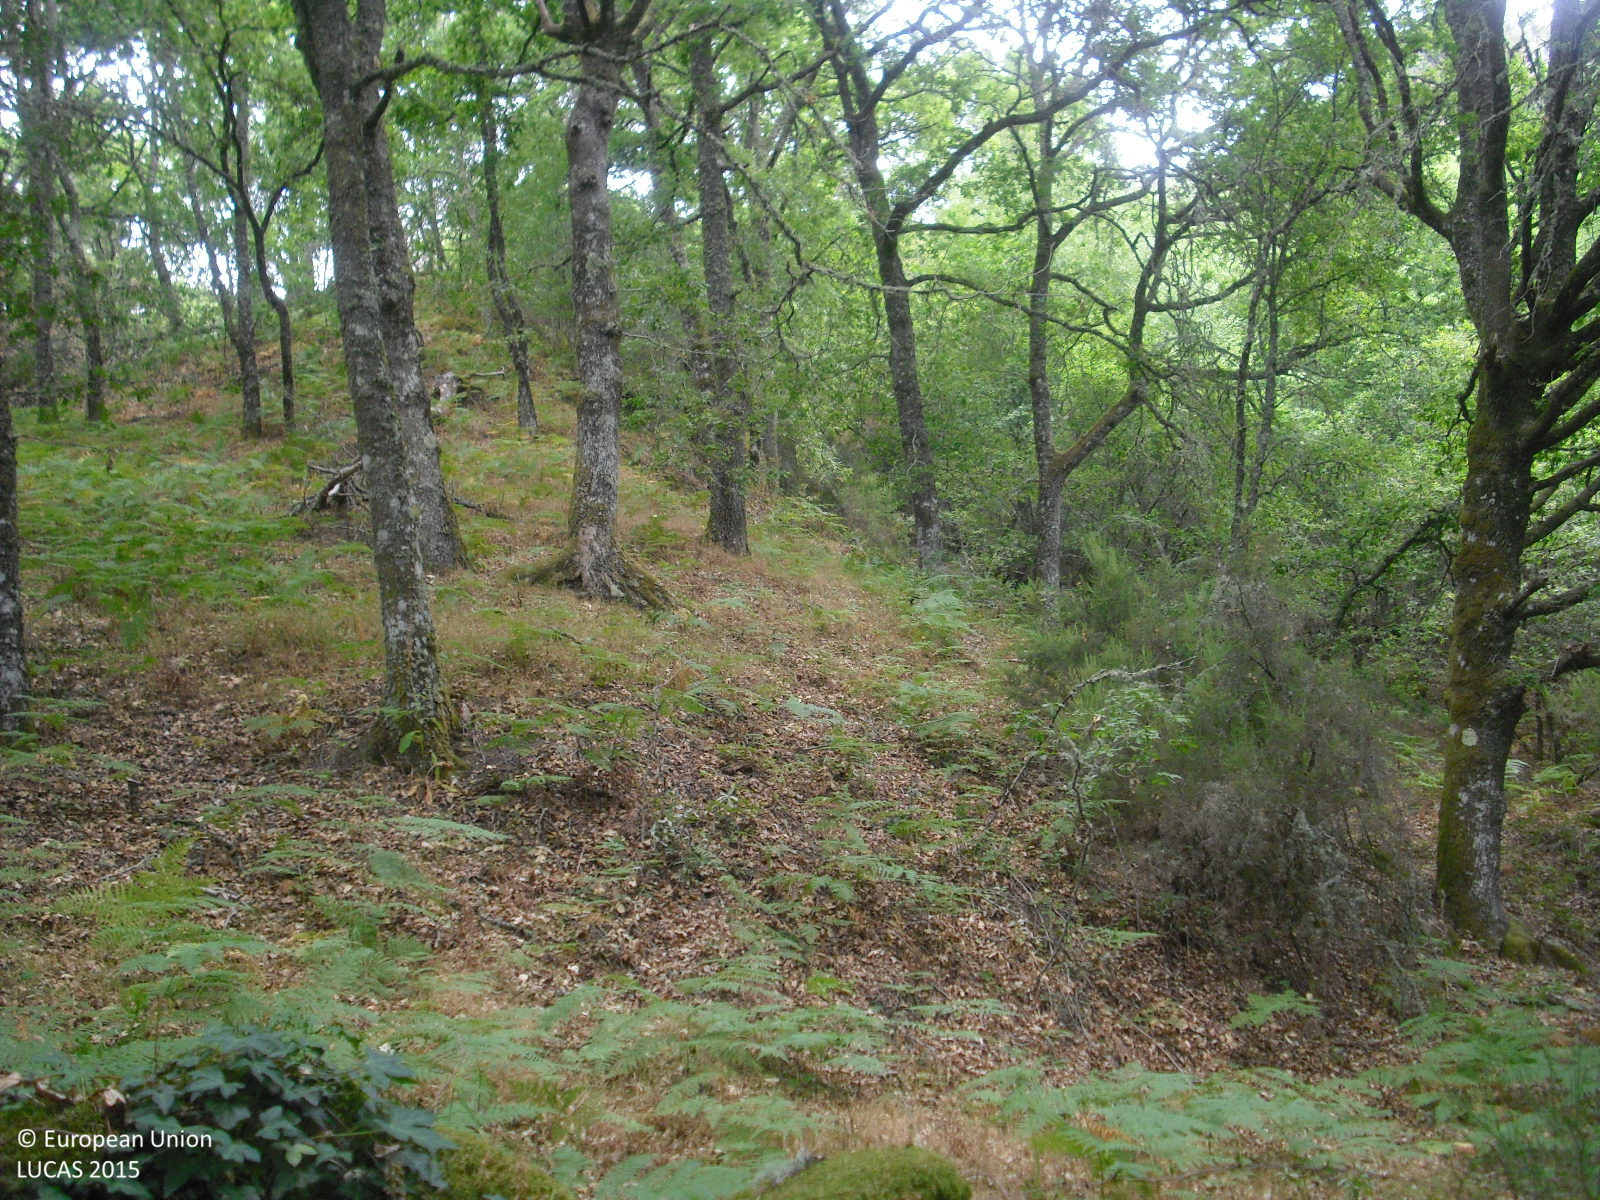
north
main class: Woodland
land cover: Broadleaved woodland
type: thermophilous deciduous forest
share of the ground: > 75 %
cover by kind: broadleaved forest trees 90 %, shrubs 10 %
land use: Forestry
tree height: > 5 m
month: July
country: ES
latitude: 42.3901
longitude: -7.6989
